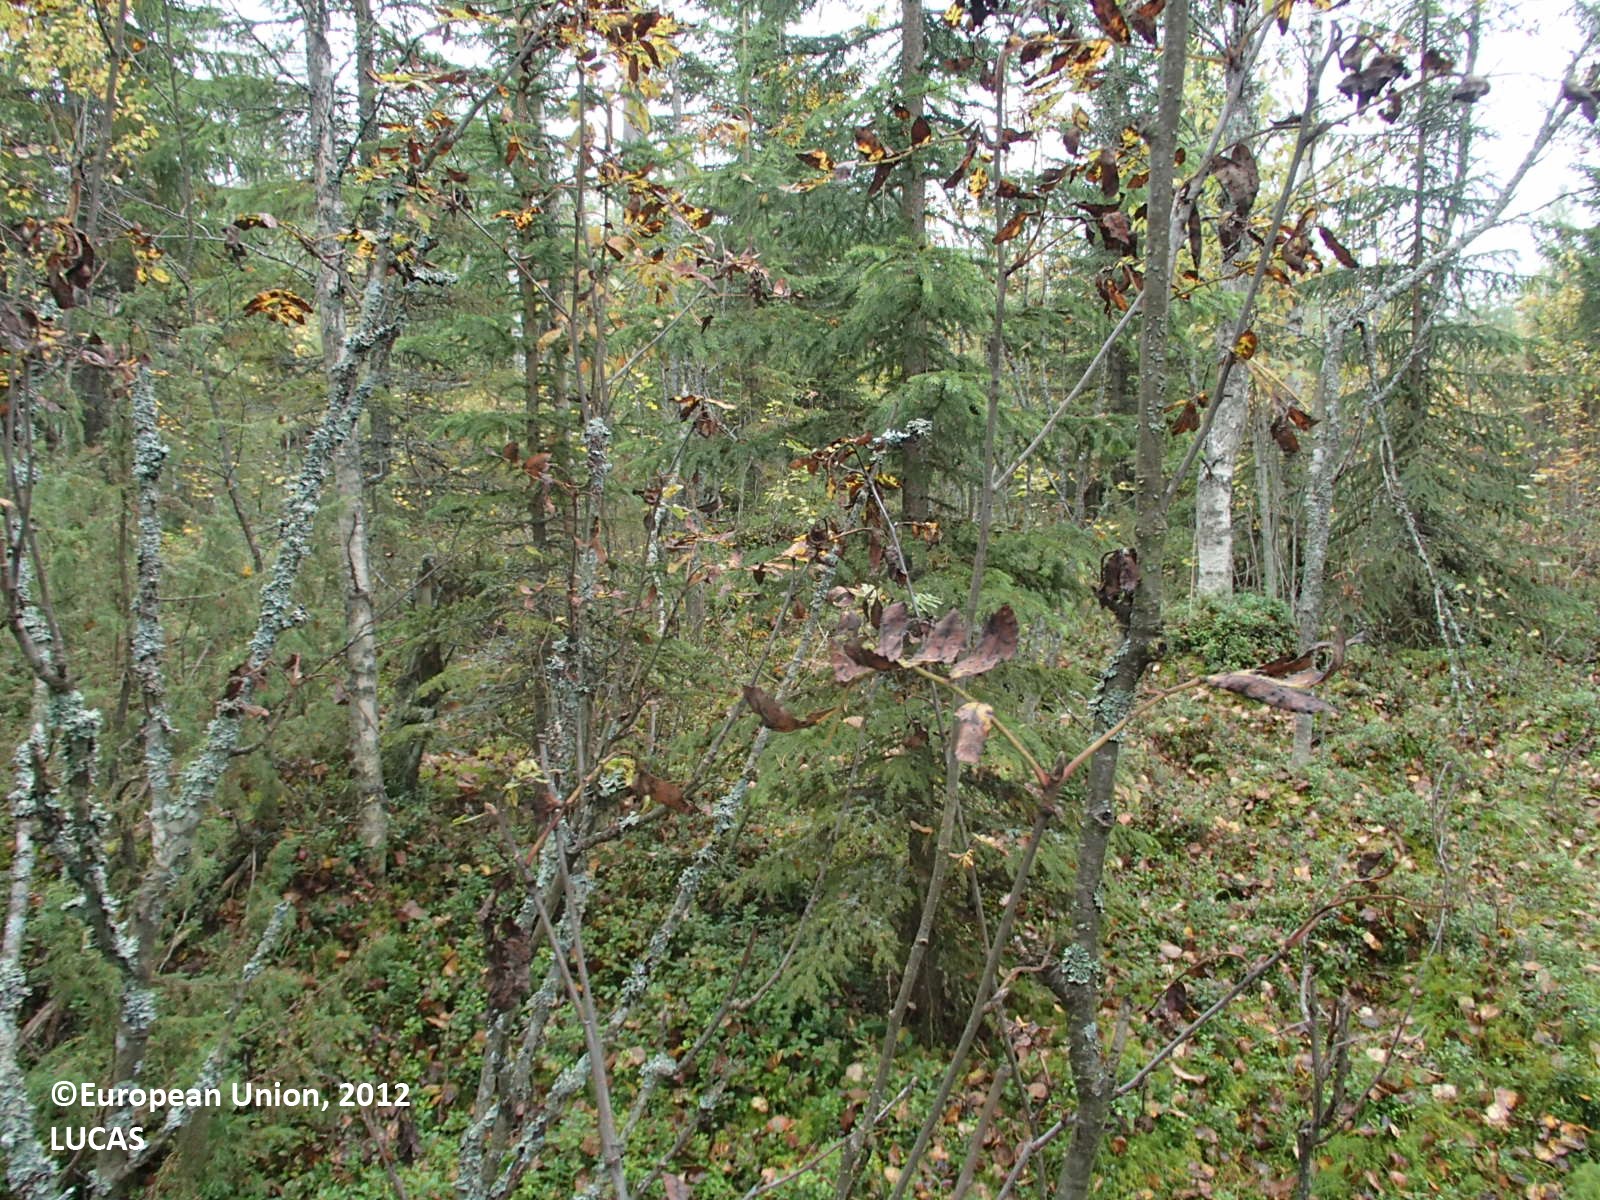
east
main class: Woodland
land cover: Spruce dominated mixed woodland
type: boreal forest
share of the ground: 50 - 75 %
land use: Forestry
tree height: > 5 m
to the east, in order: Spruce dominated mixed woodland; Broadleaved woodland; Ditches and canals; Broadleaved woodland; Other mixed woodland; Spontaneously vegetated surfaces; Ditches and canals; Temporary grasslands; Grass margins; Ditches and canals; Abandoned hedges; Paved roads, cycling and walking lanes
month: September
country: FI
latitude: 63.8685
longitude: 26.9231
